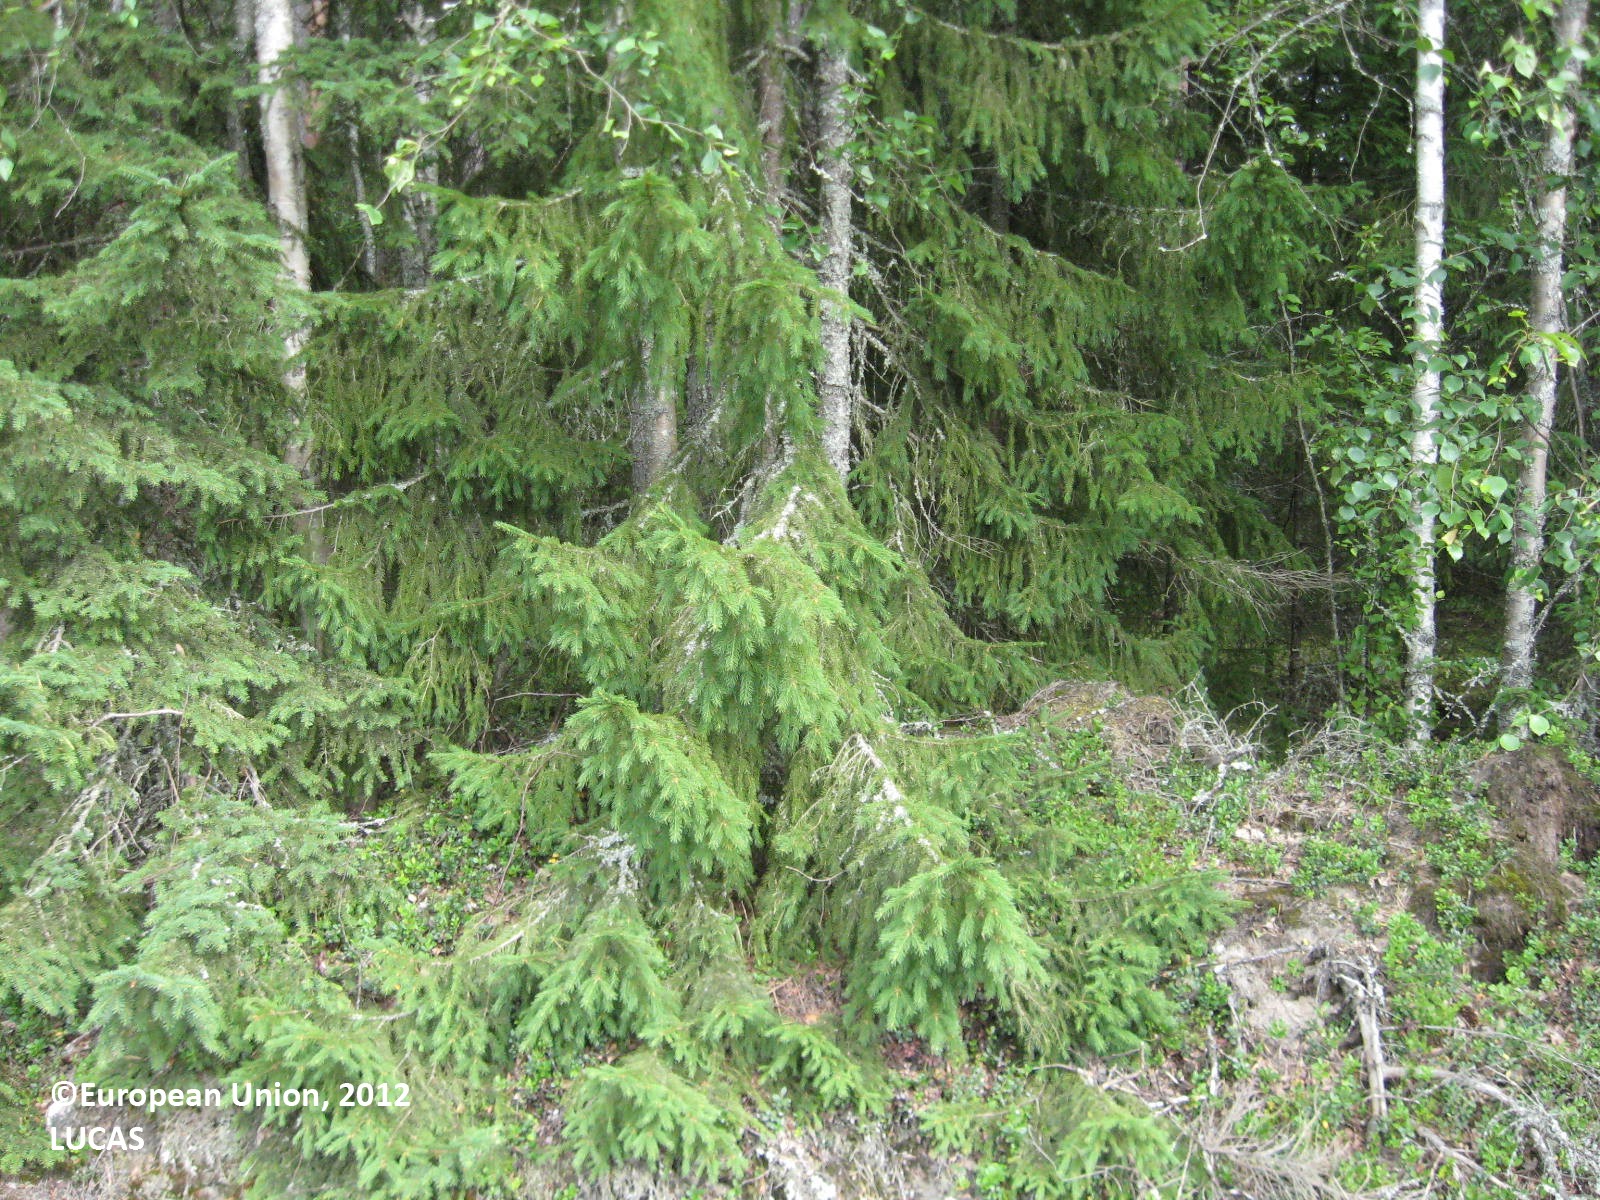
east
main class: Cropland
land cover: Oats
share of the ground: > 75 %
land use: Agriculture (excluding fallow land and kitchen gardens)
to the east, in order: Oats; Ditches and canals; Oats; Grass margins; Ditches and canals; Other coniferous woodland; Pine dominated coniferous woodland; Other mixed woodland
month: July
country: FI
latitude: 62.5770
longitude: 21.1917
